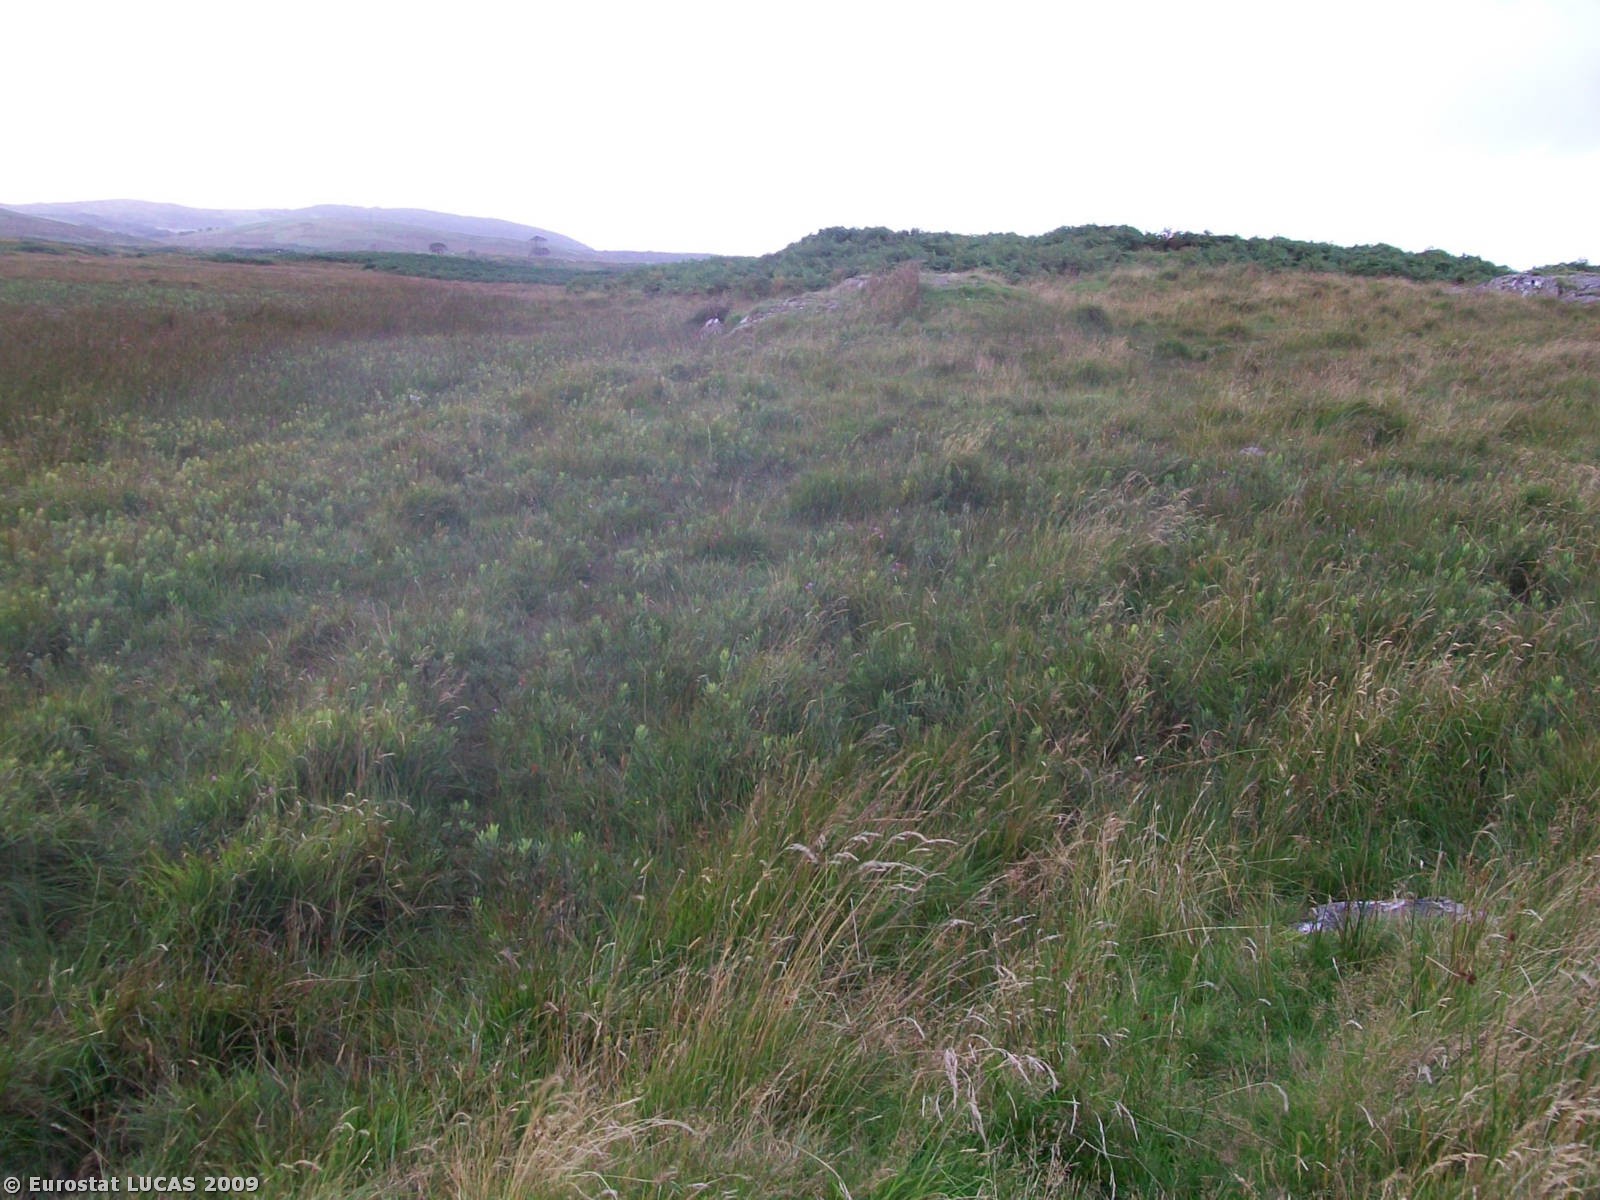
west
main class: Grassland
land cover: Grassland without tree/shrub cover
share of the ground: > 75 %
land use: Agriculture (excluding fallow land and kitchen gardens)
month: August
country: GB
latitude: 54.9070
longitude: -4.7533
